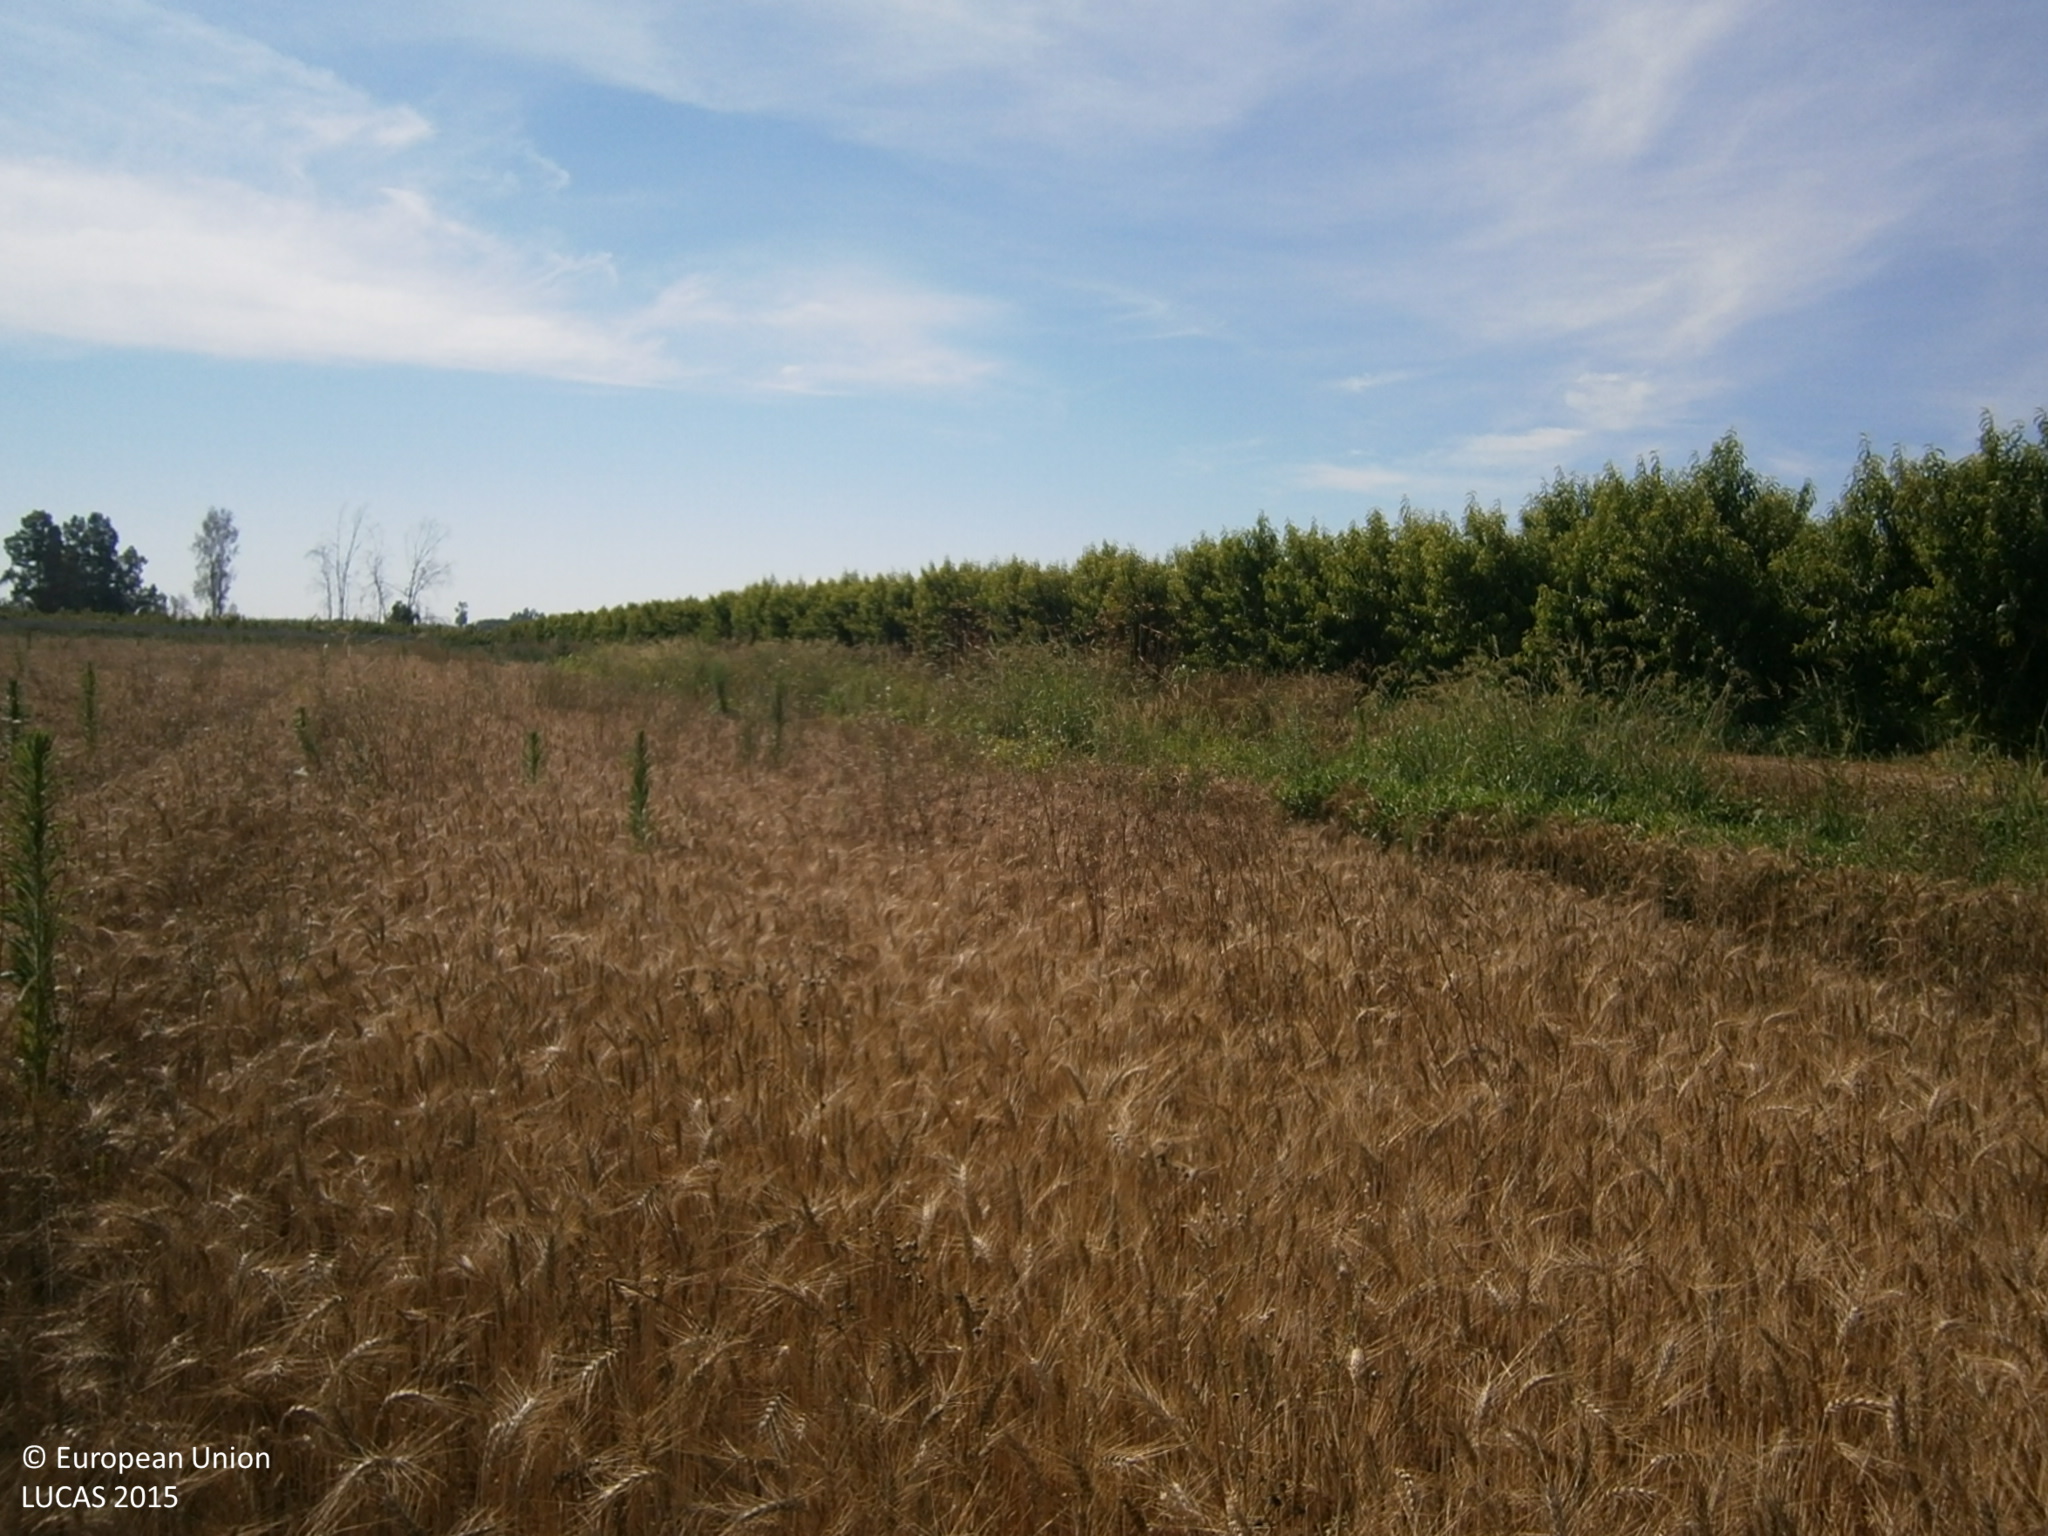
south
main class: Cropland
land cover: Durum wheat
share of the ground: > 75 %
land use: Agriculture (excluding fallow land and kitchen gardens)
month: June
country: ES
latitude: 38.8724
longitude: -6.5313
